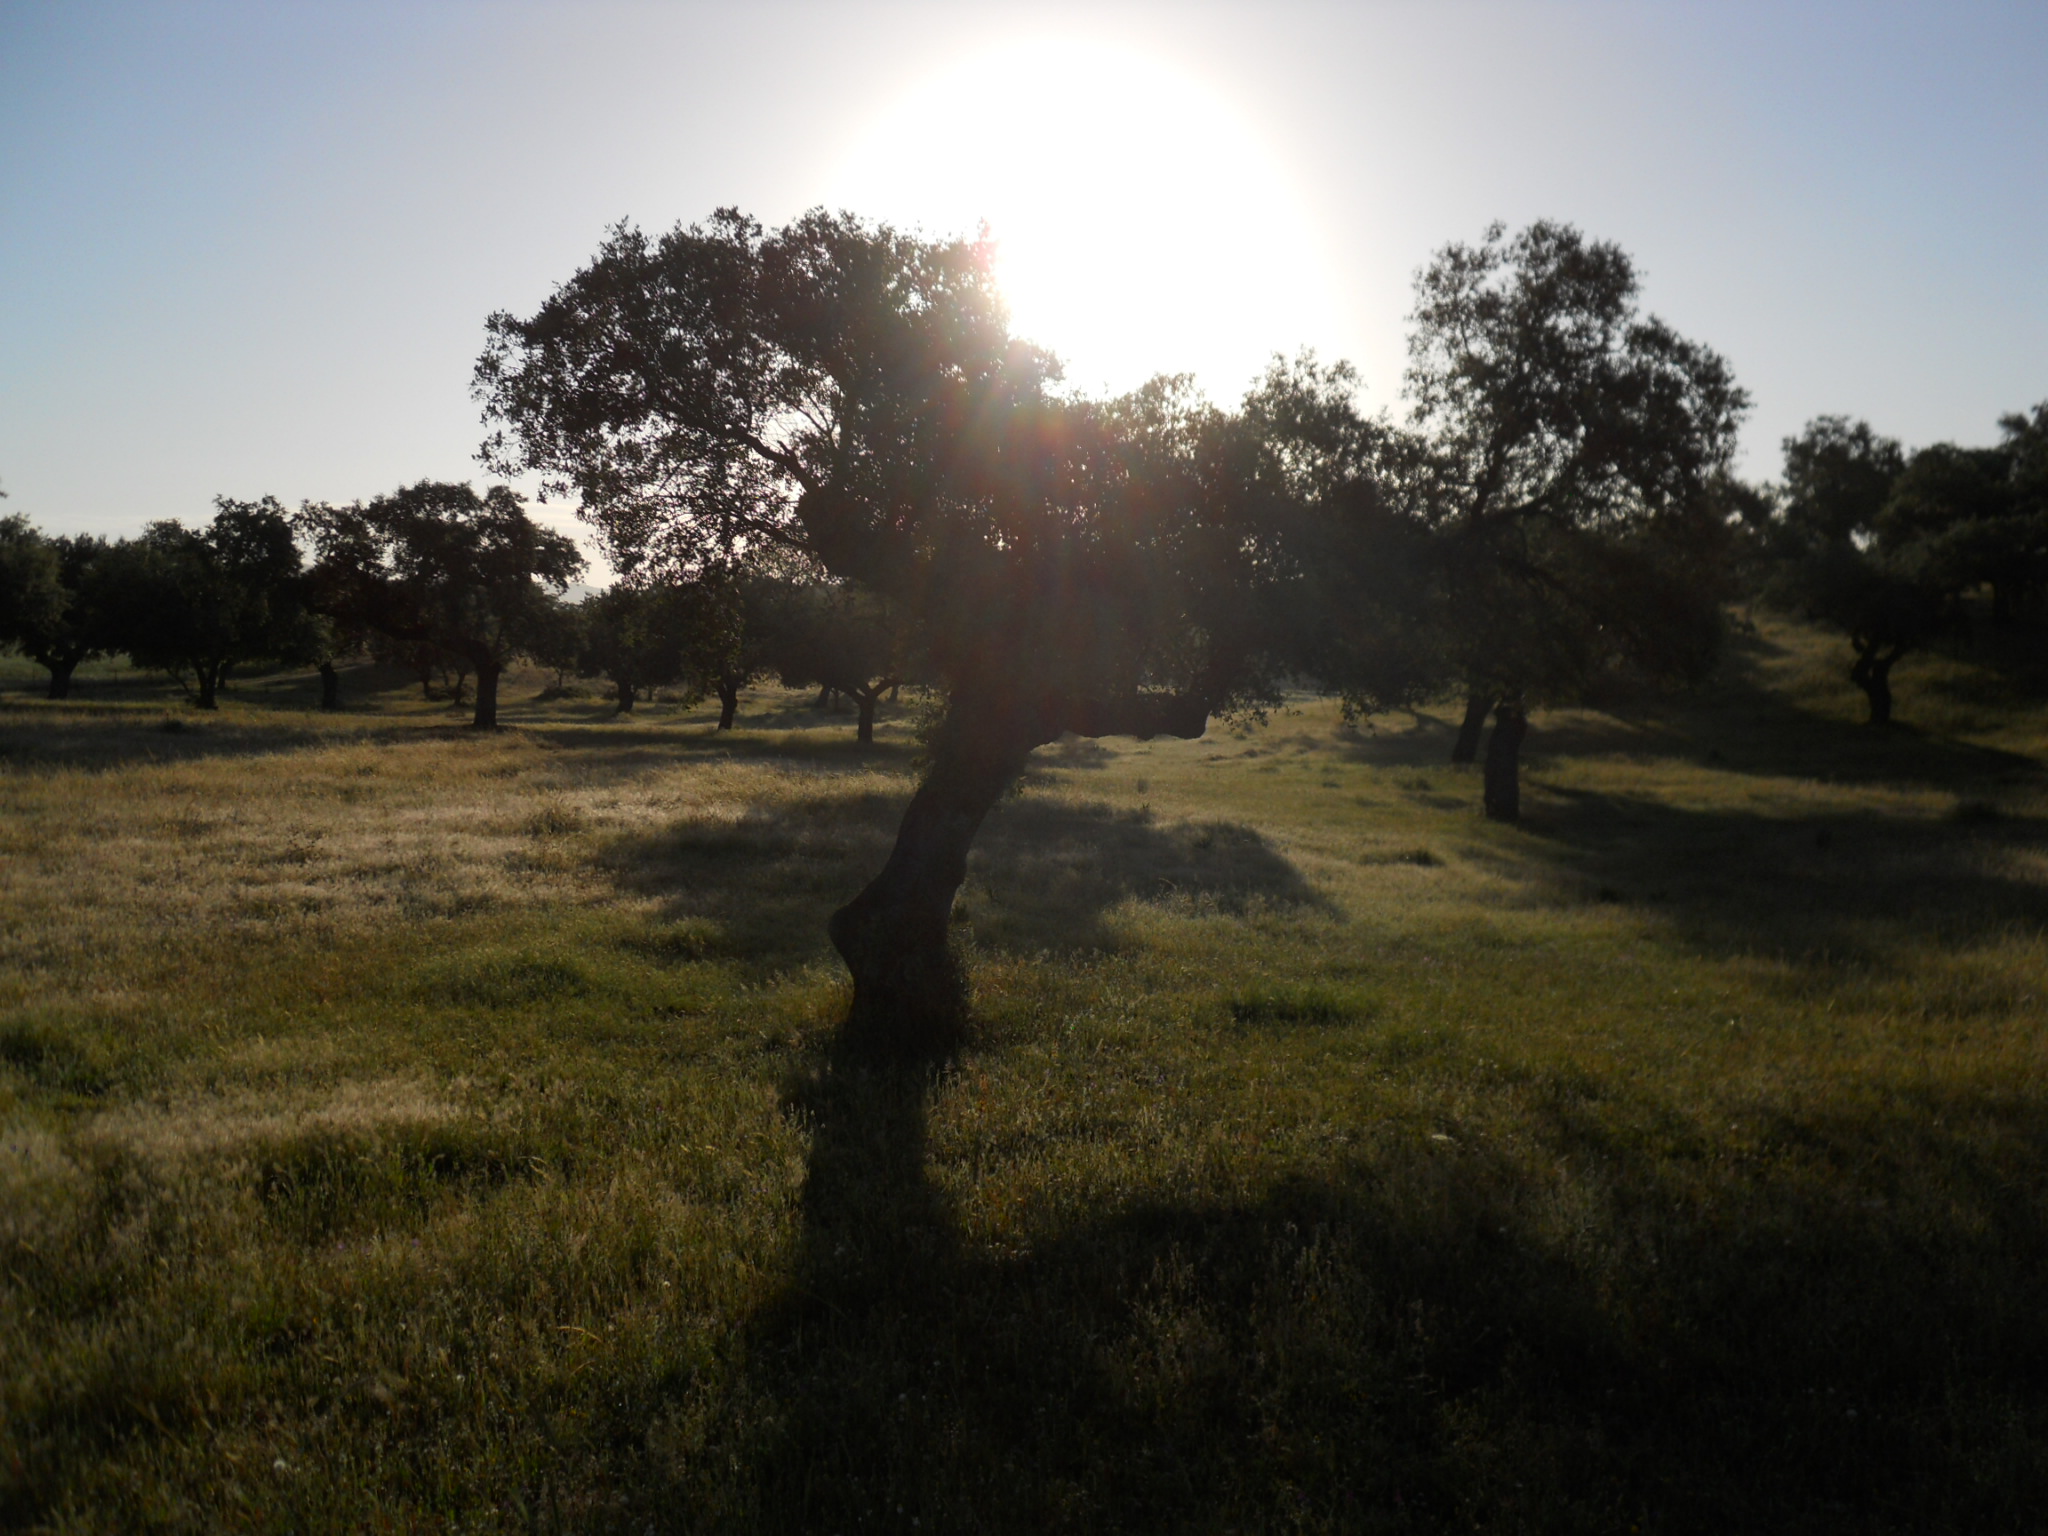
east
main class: Woodland
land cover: Broadleaved woodland
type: broadleaved evergreen forest
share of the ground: 25 - 50 %
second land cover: Grassland without tree/shrub cover
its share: > 75 %
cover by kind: herbaceous plants 70 %, broadleaved forest trees 30 %
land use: Forestry
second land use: Agriculture (excluding fallow land and kitchen gardens)
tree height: > 5 m
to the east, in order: Broadleaved woodland; Grassland without tree/shrub cover
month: May
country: ES
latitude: 39.1208
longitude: -6.9019
